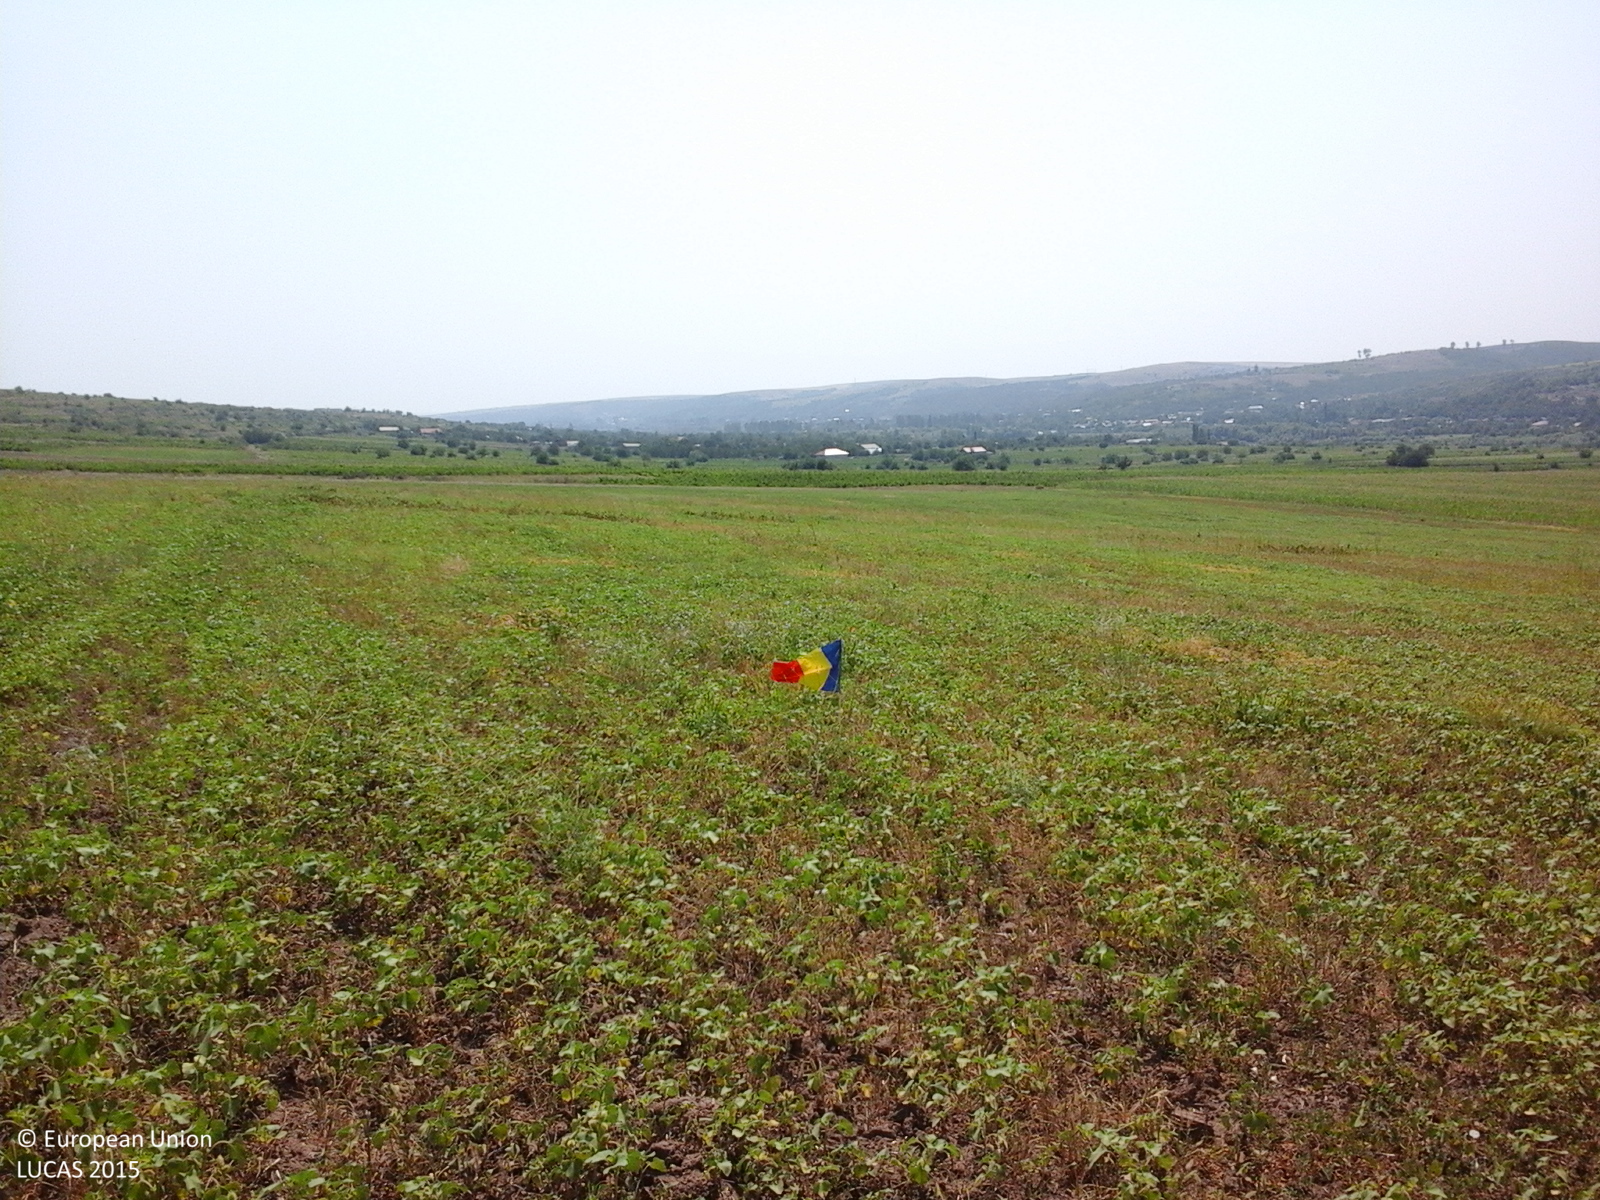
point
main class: Grassland
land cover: Spontaneously vegetated surfaces
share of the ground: > 75 %
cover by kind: herbaceous plants 100 %
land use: Agriculture (excluding fallow land and kitchen gardens)
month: July
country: RO
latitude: 45.8090
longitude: 27.9677
